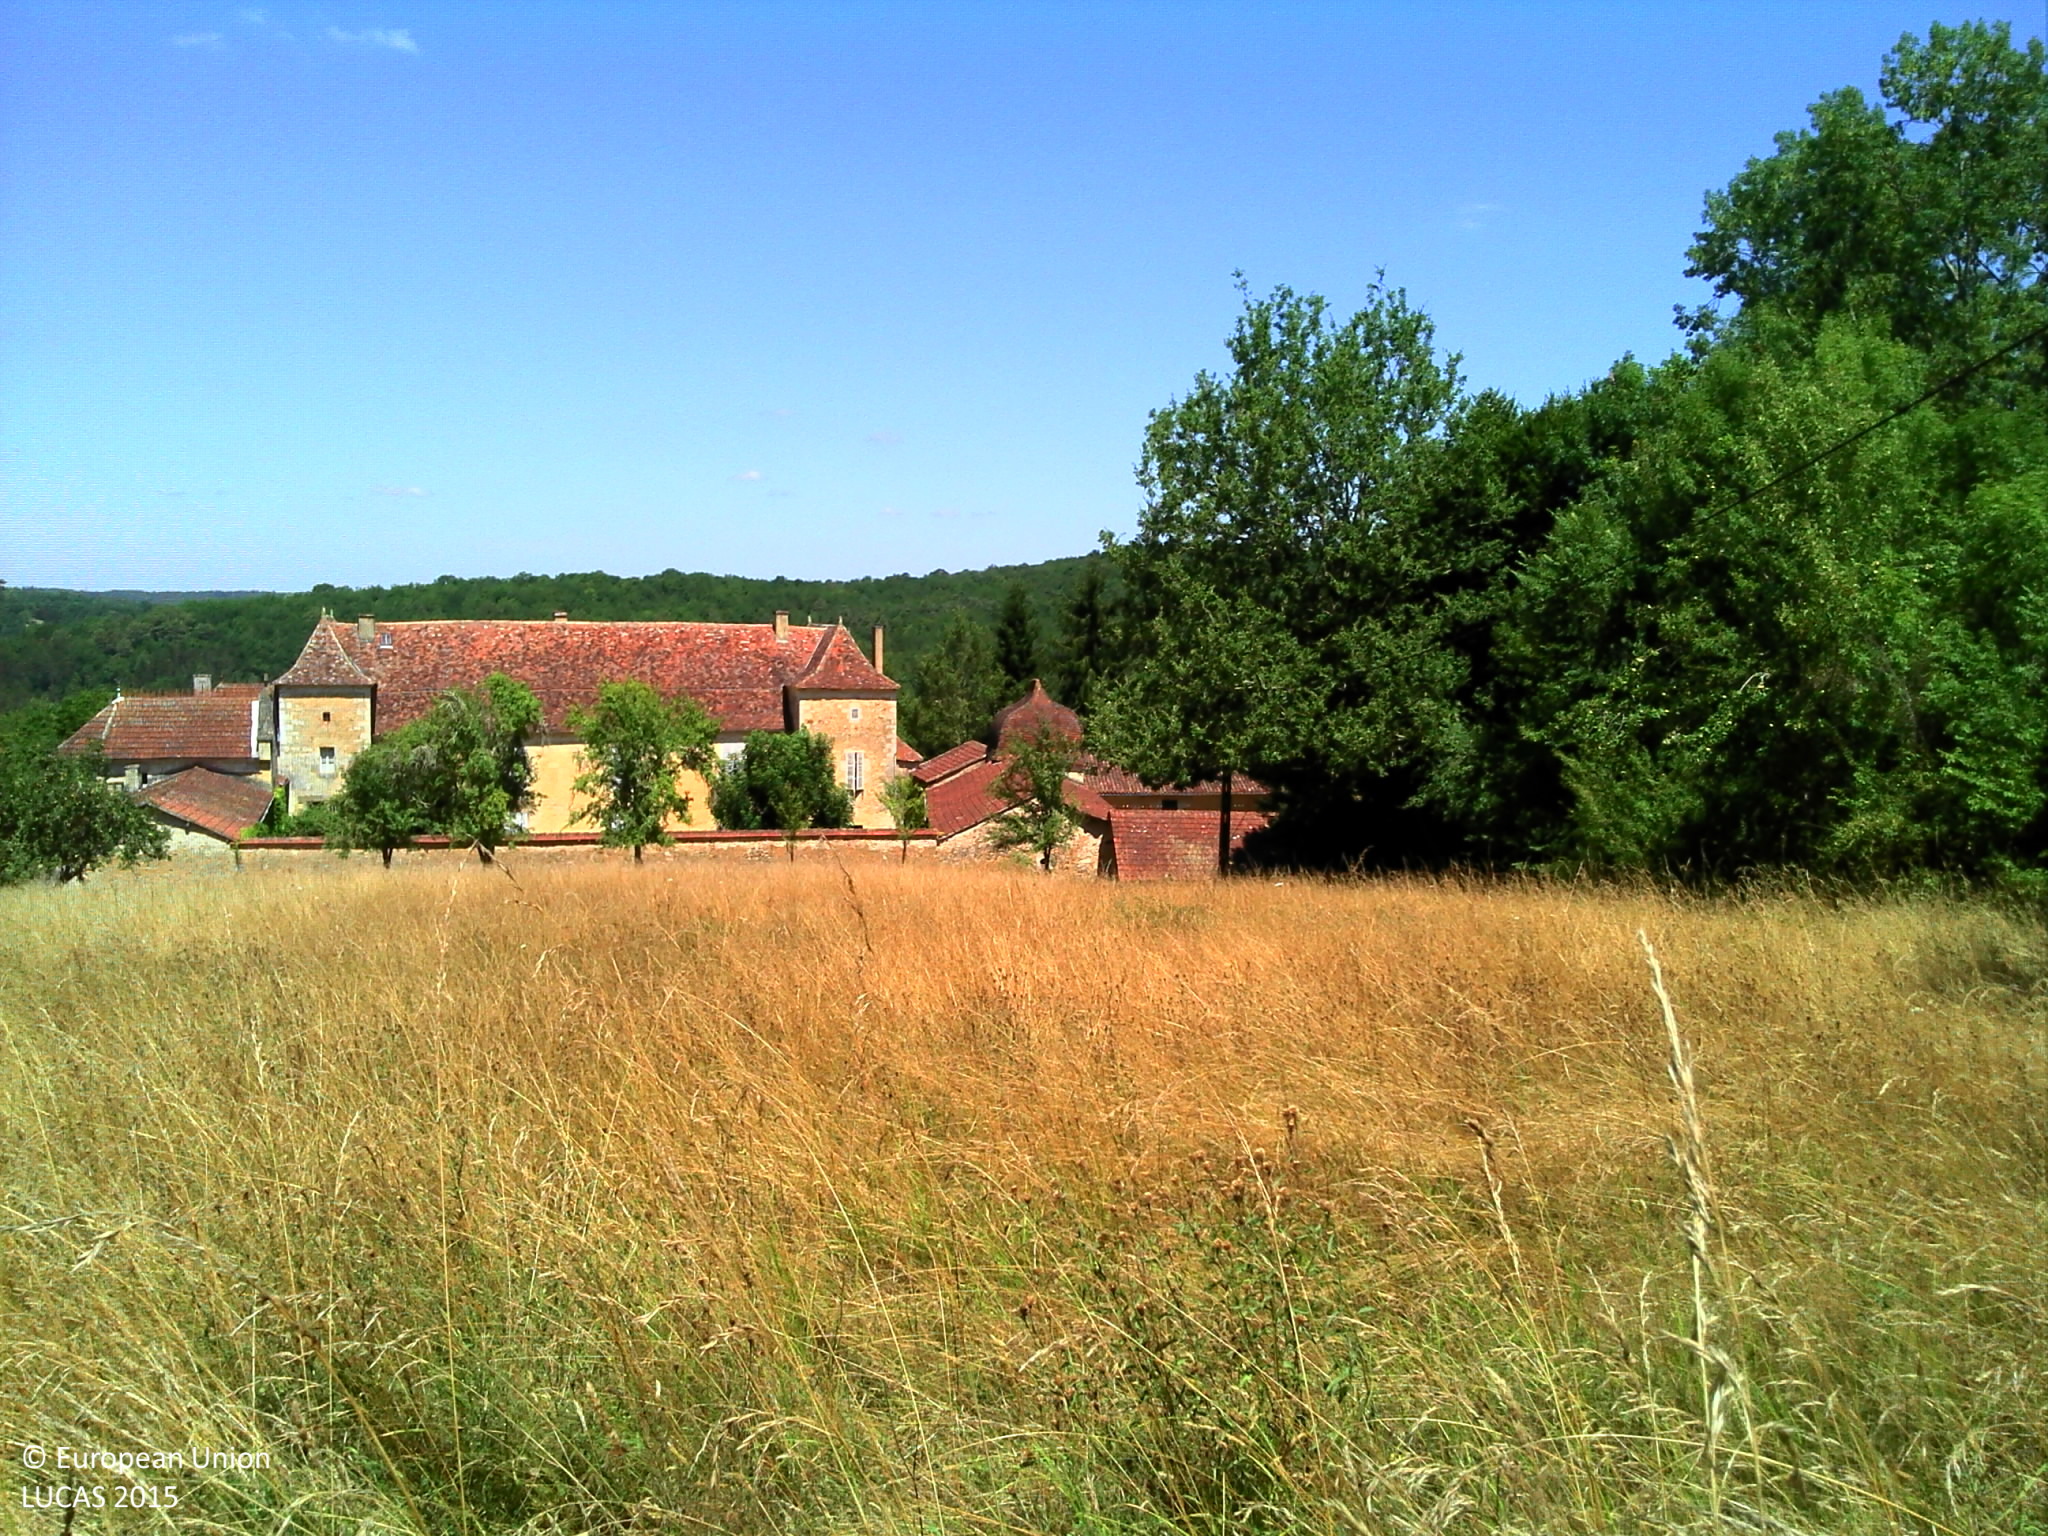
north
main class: Grassland
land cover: Grassland without tree/shrub cover
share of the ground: > 75 %
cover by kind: herbaceous plants 100 %
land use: Agriculture (excluding fallow land and kitchen gardens)
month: July
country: FR
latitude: 44.8810
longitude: 0.5591
